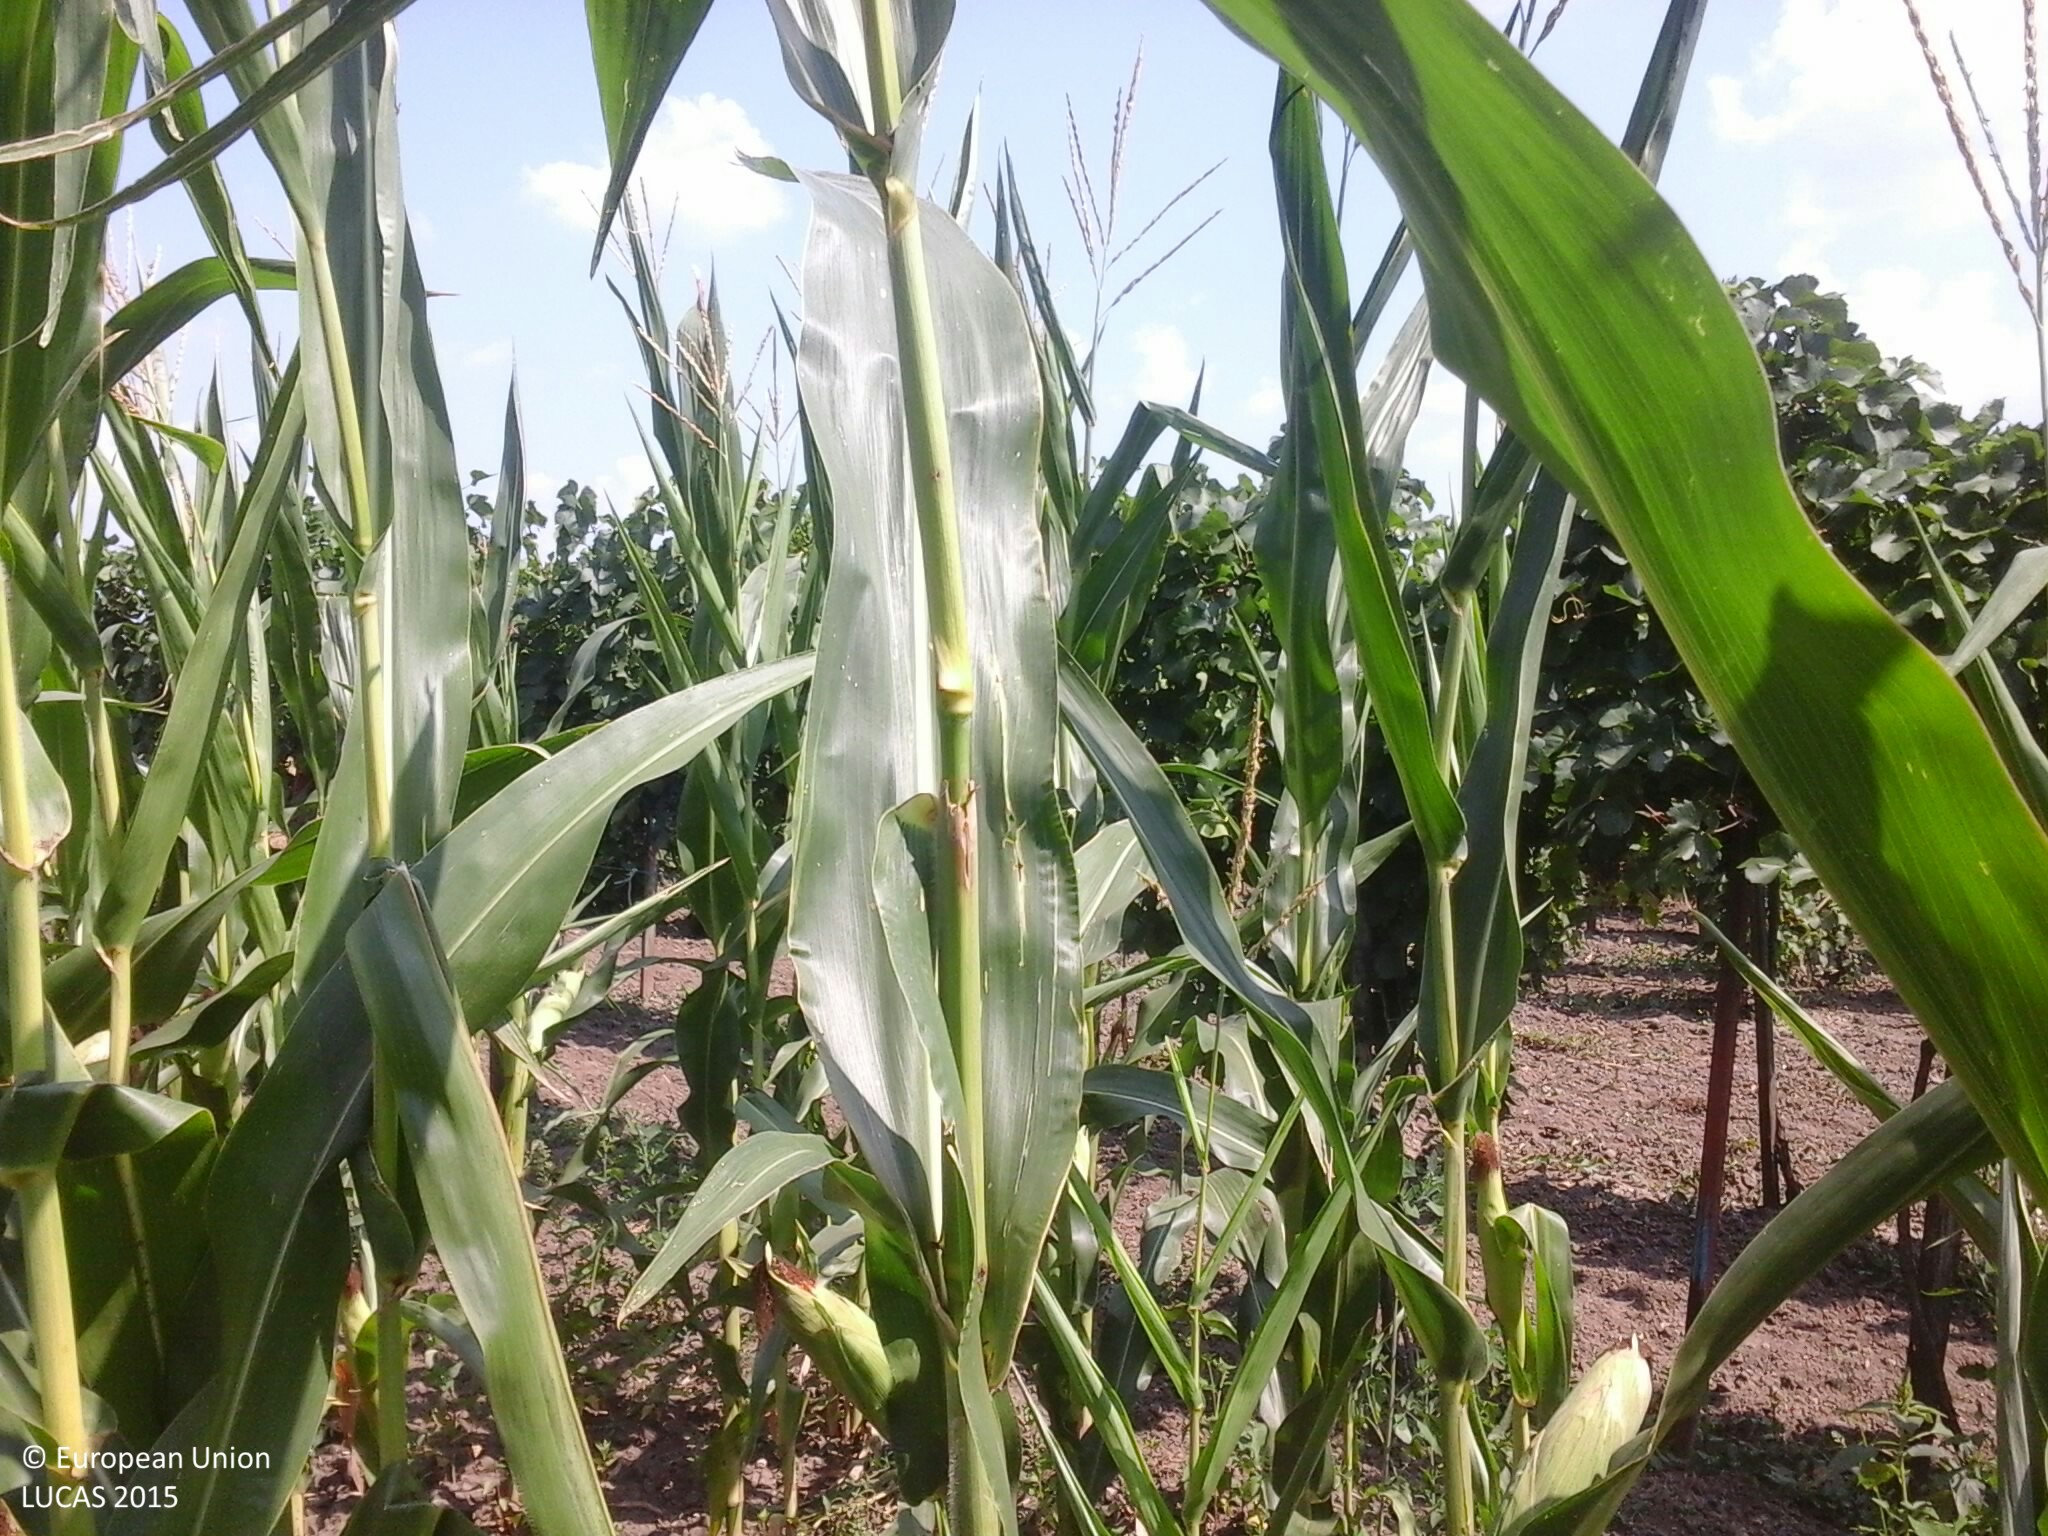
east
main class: Cropland
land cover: Maize
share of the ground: > 75 %
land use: Agriculture (excluding fallow land and kitchen gardens)
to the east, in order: Maize; Vineyards; Common wheat; Grassland with sparse tree/shrub cover; Artificial constructions in urban areas; Grassland without tree/shrub cover; Lines of trees; Grass margins; Tracks; Grass margins; Electric lines; Grass margins; Vineyards; Grassland with sparse tree/shrub cover; Arable land (only in case pi)
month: August
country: HU
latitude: 47.0088
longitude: 18.2578
